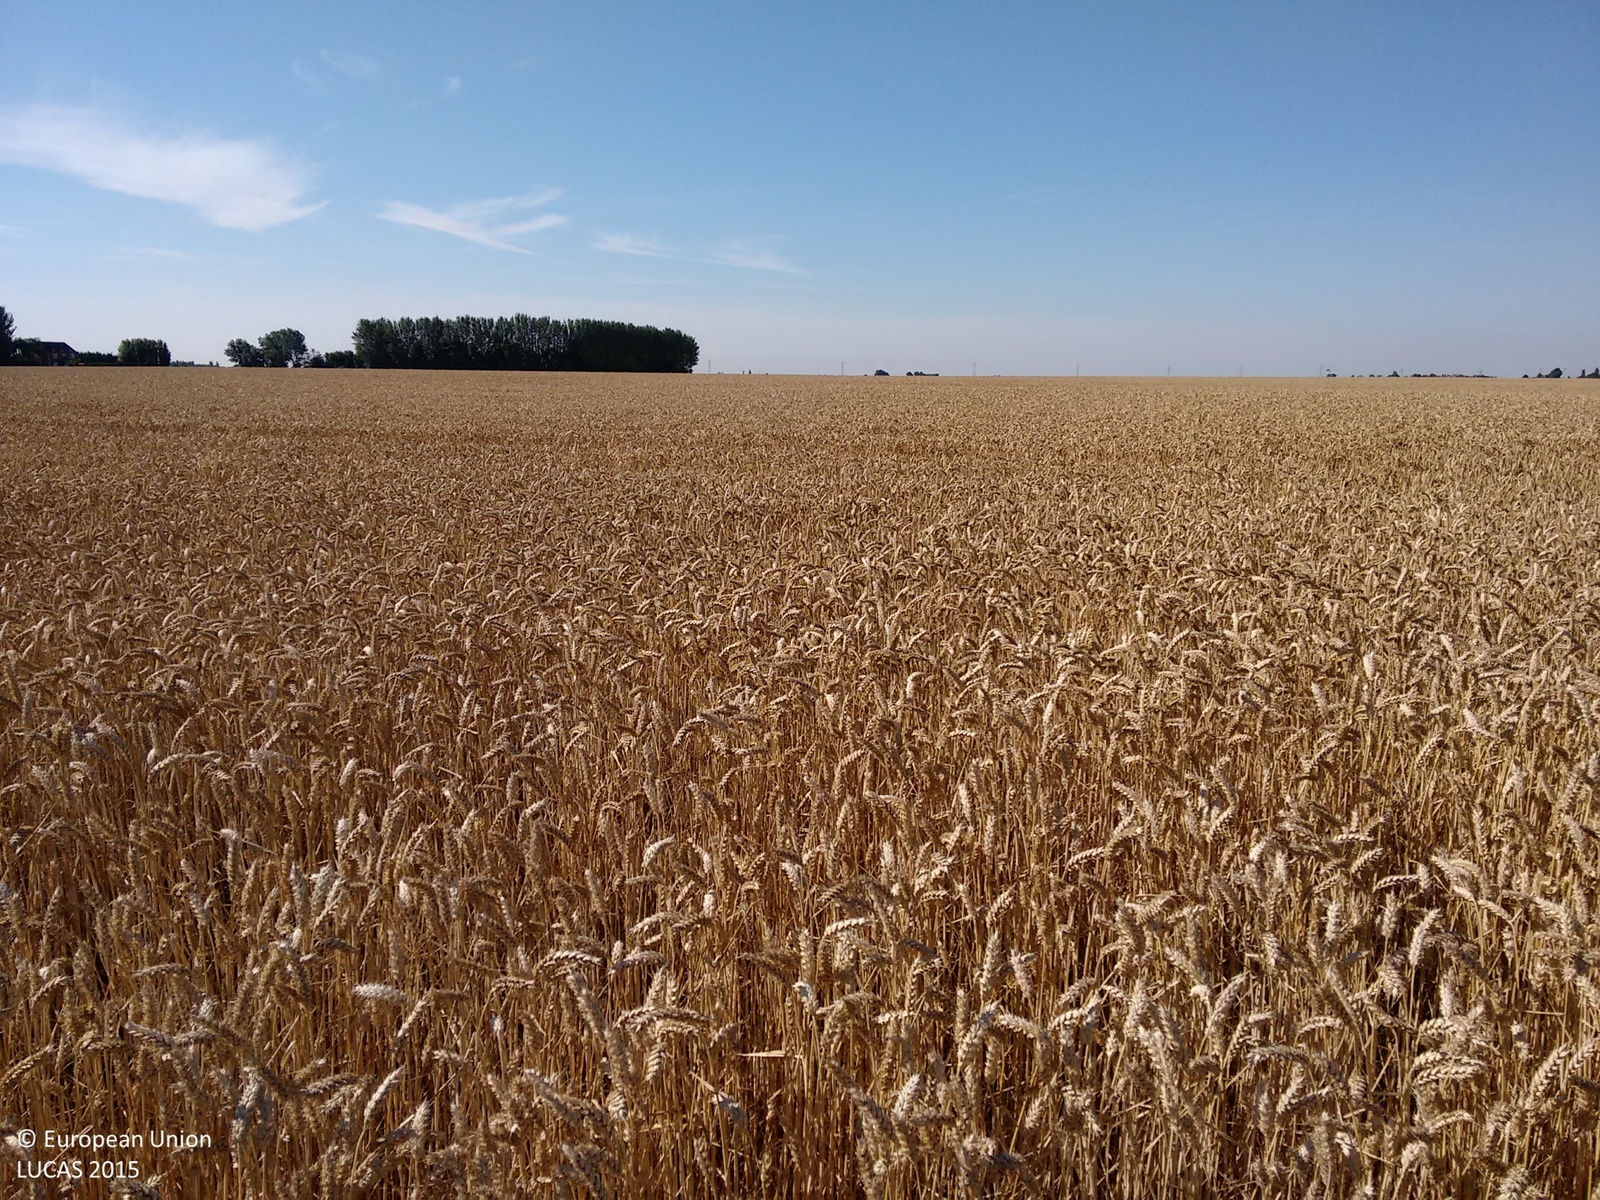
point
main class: Cropland
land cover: Common wheat
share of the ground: > 75 %
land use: Agriculture (excluding fallow land and kitchen gardens)
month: July
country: GB
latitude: 52.6979
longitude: 0.0090
